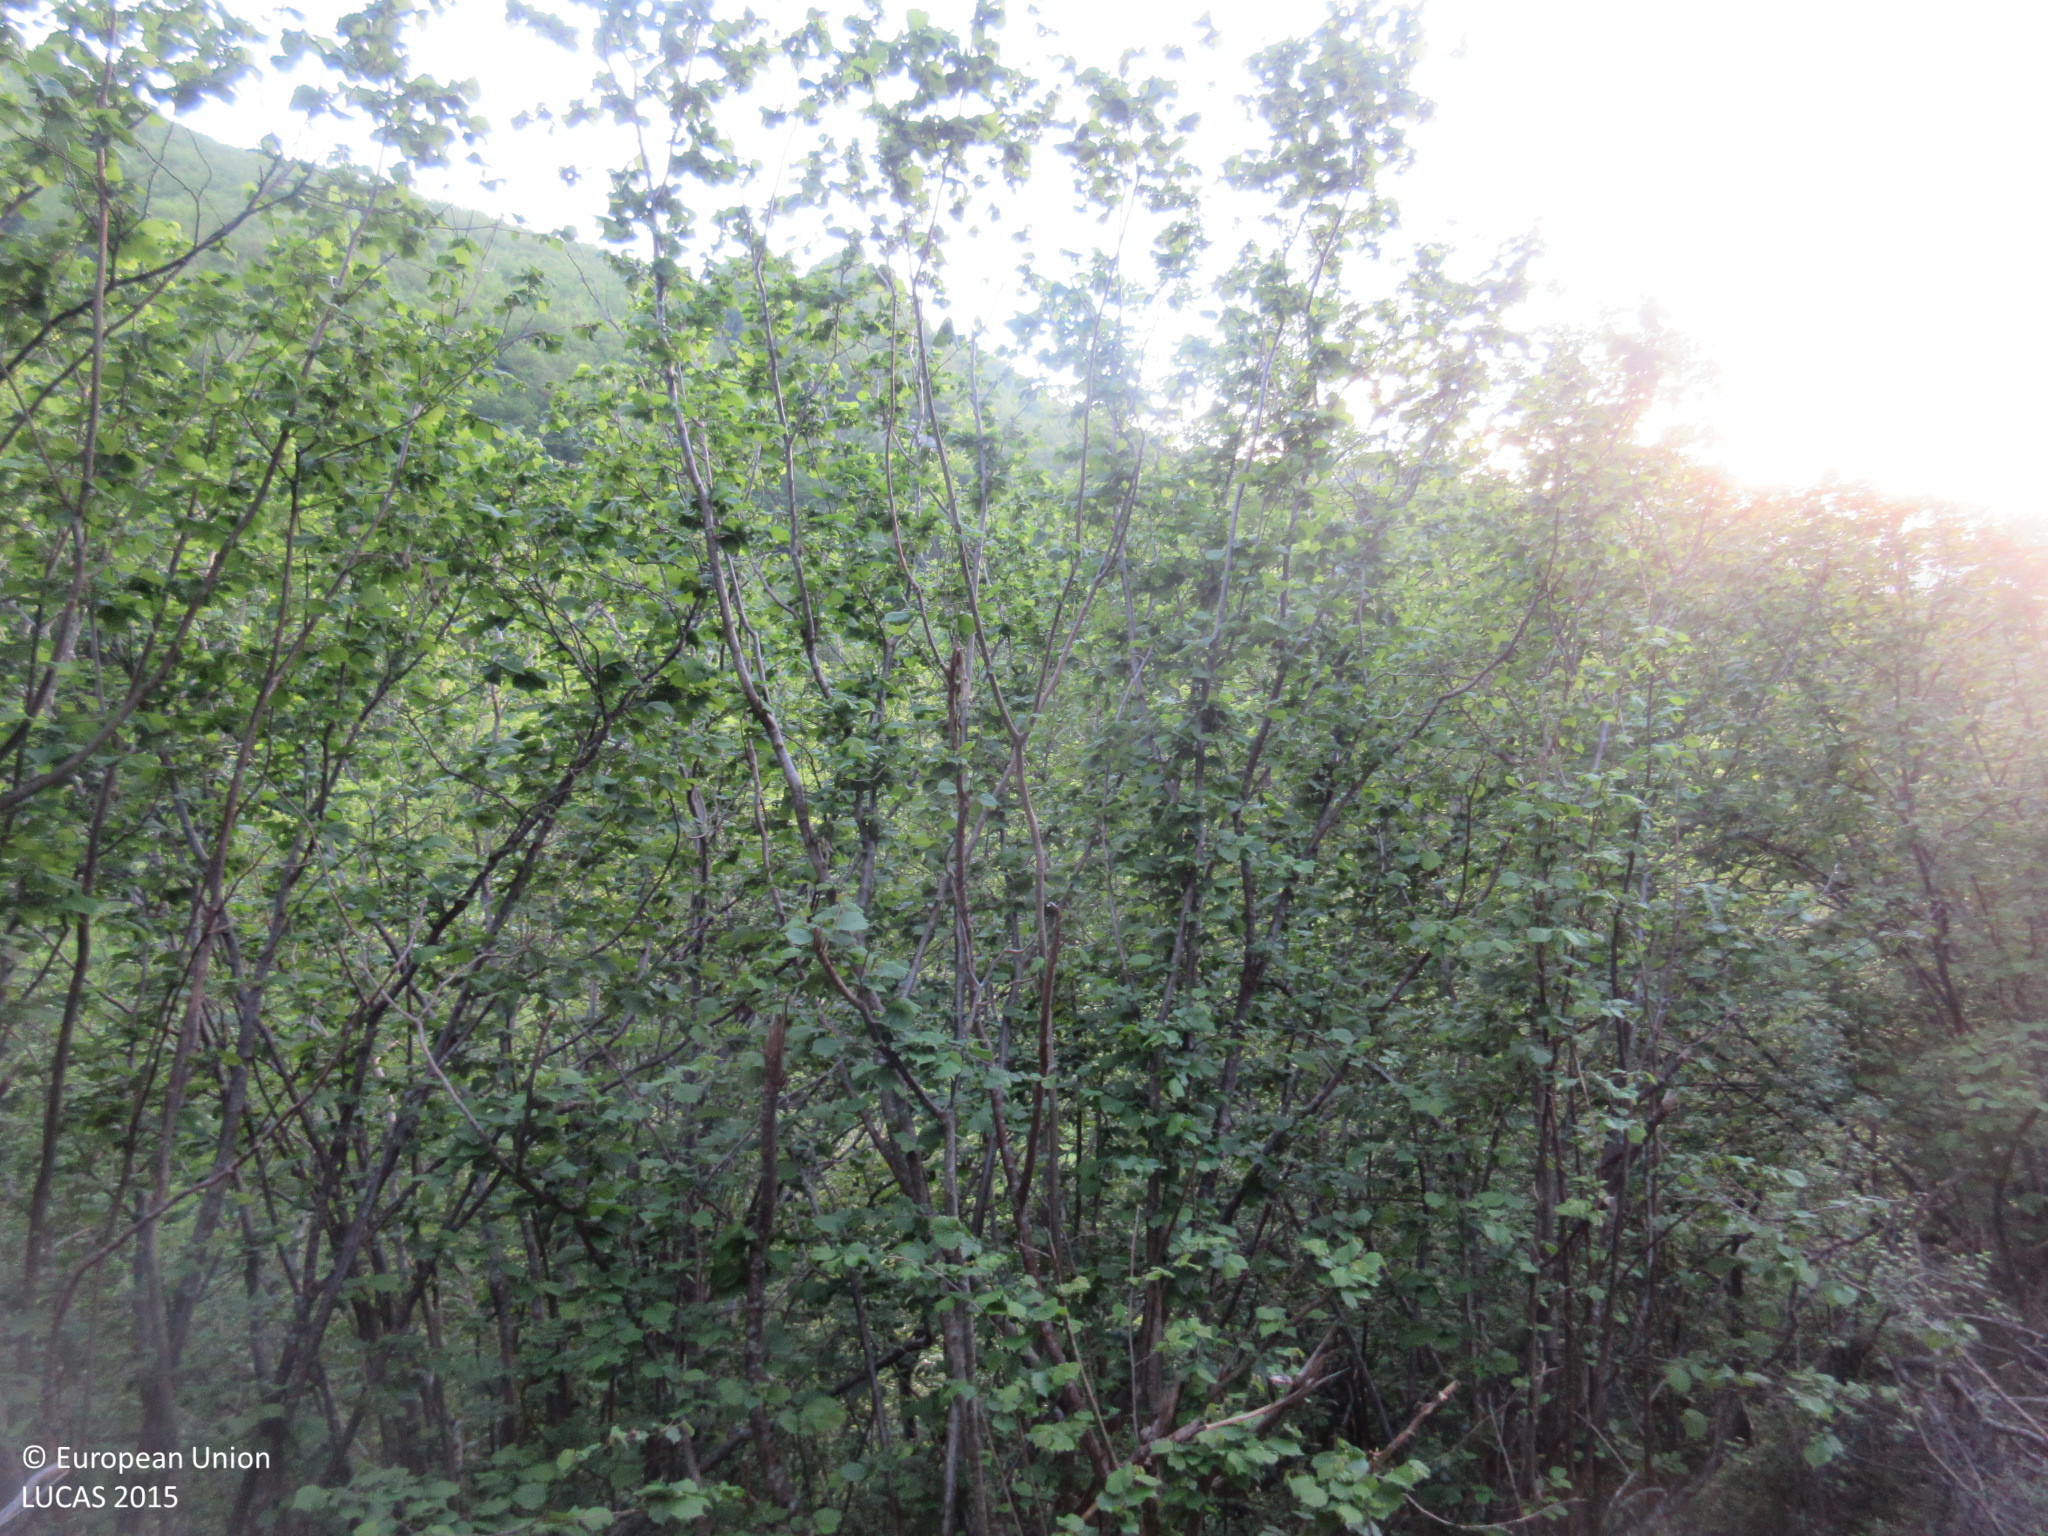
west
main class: Shrubland
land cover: Shrubland with sparse tree cover
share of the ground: > 75 %
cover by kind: shrubs 95 %, broadleaved forest trees 5 %
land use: Semi-natural and natural areas not in use
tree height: > 5 m
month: May
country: ES
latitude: 43.0830
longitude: -5.5174
